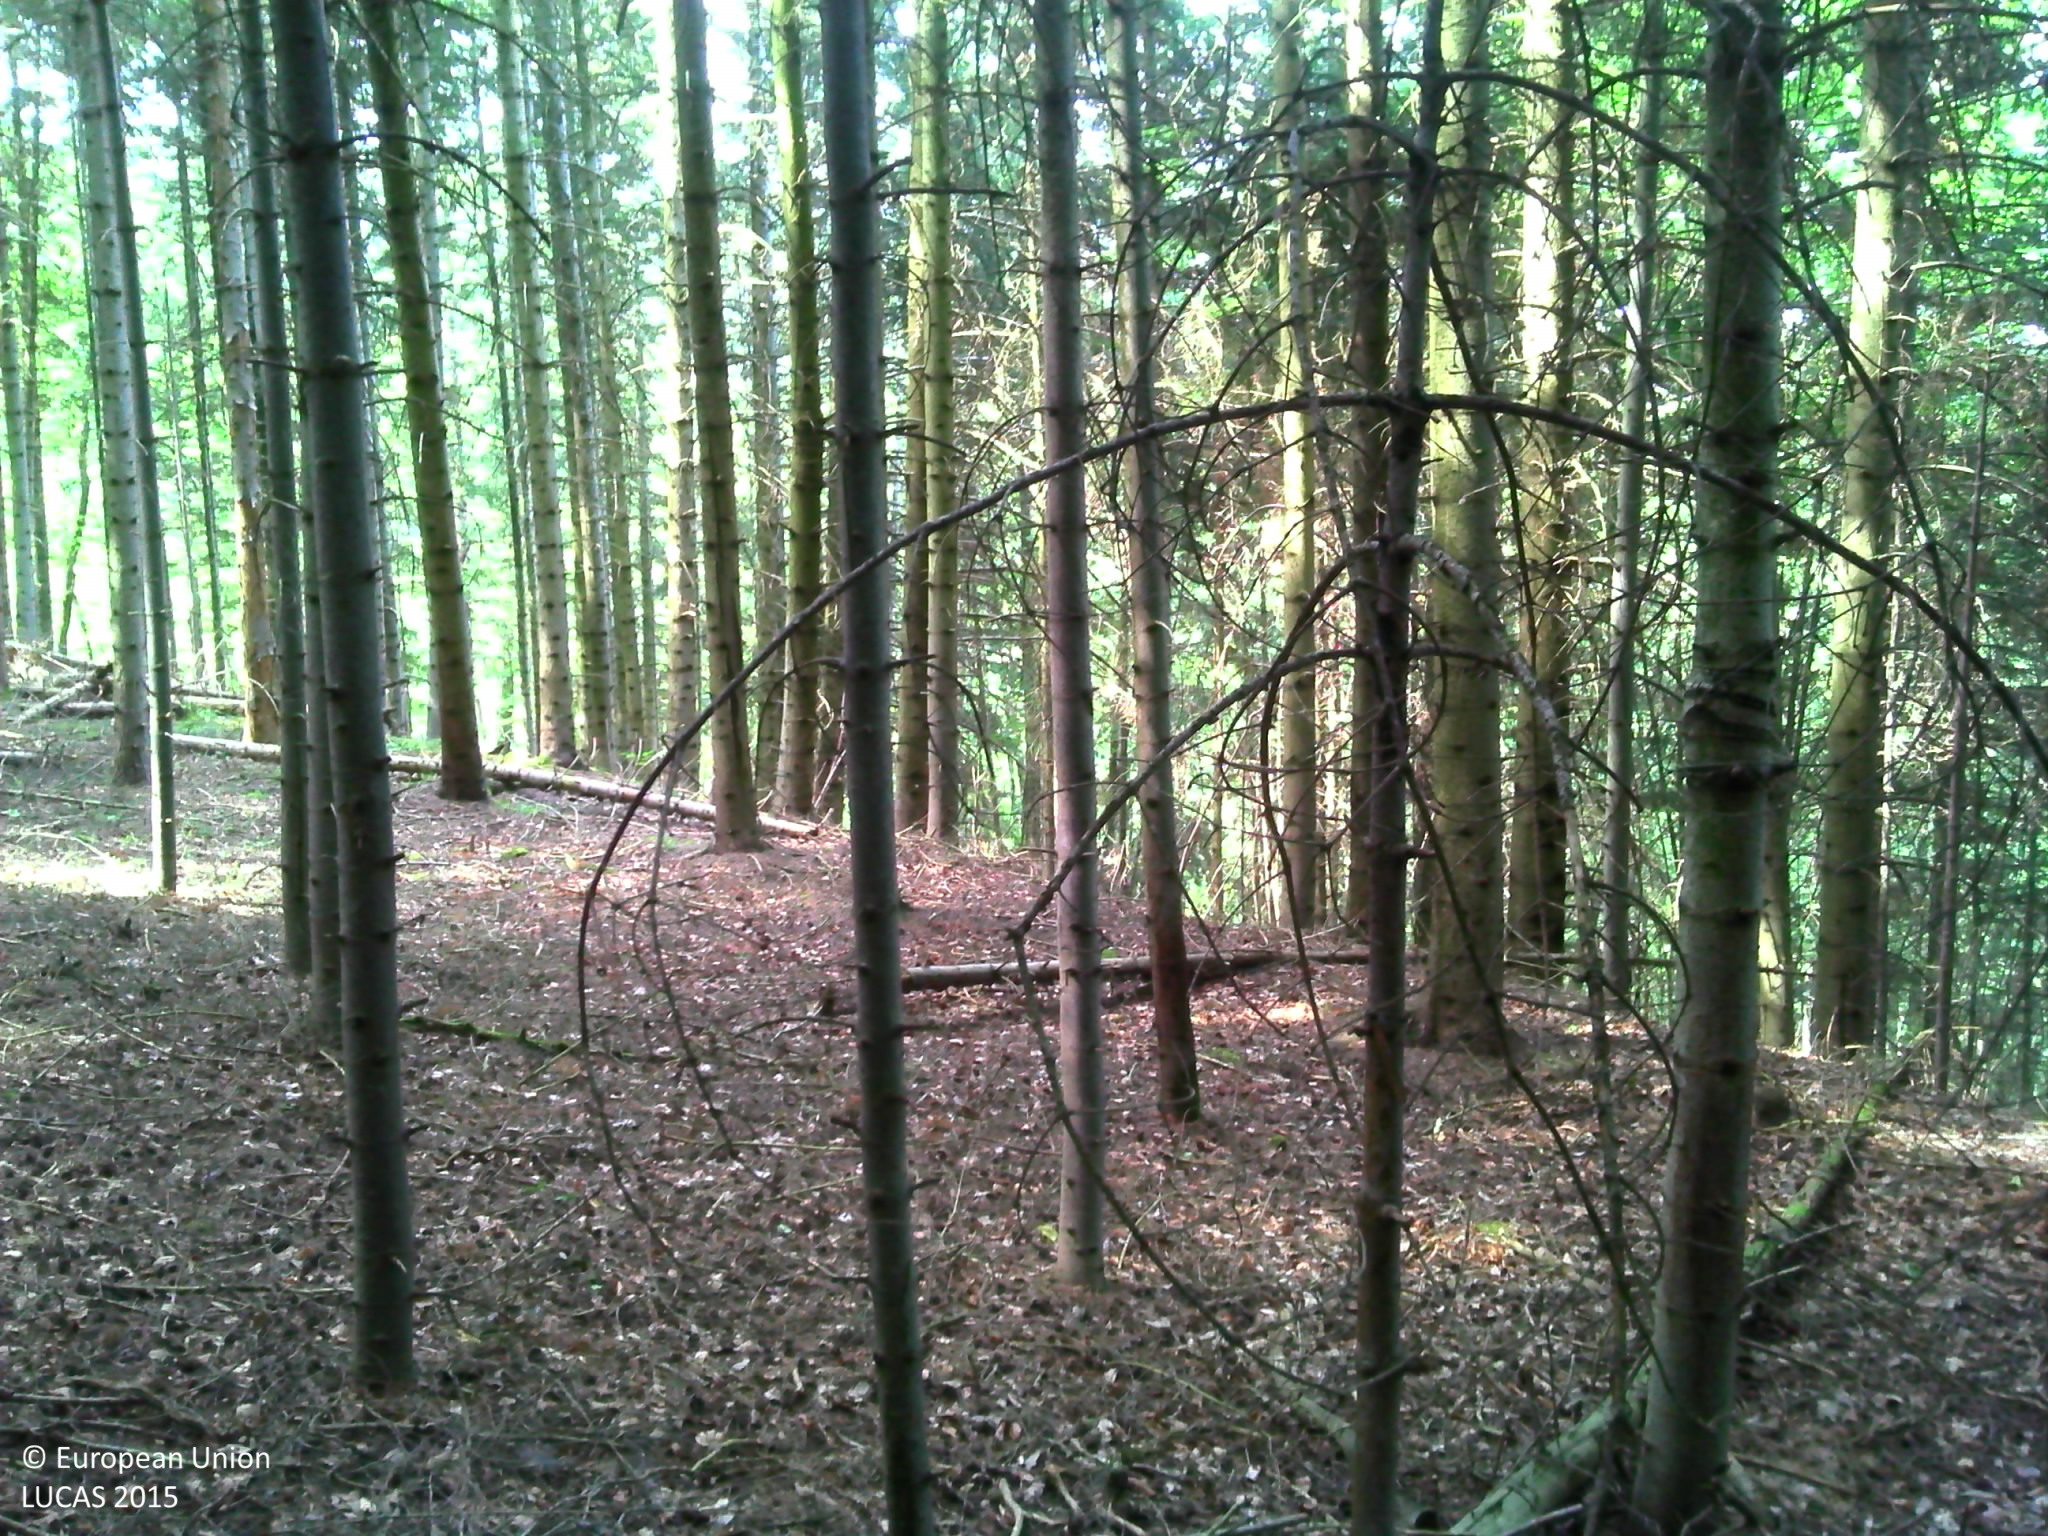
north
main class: Woodland
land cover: Spruce dominated coniferous woodland
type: hemiboreal forest and nemoral coniferous forest and mixed broadleaved-coniferous forest
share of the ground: > 75 %
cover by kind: coniferous forest trees 95 %, unconsolidated bare surface 5 %
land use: Forestry
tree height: > 5 m
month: July
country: FR
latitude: 45.1712
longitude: 3.1183
